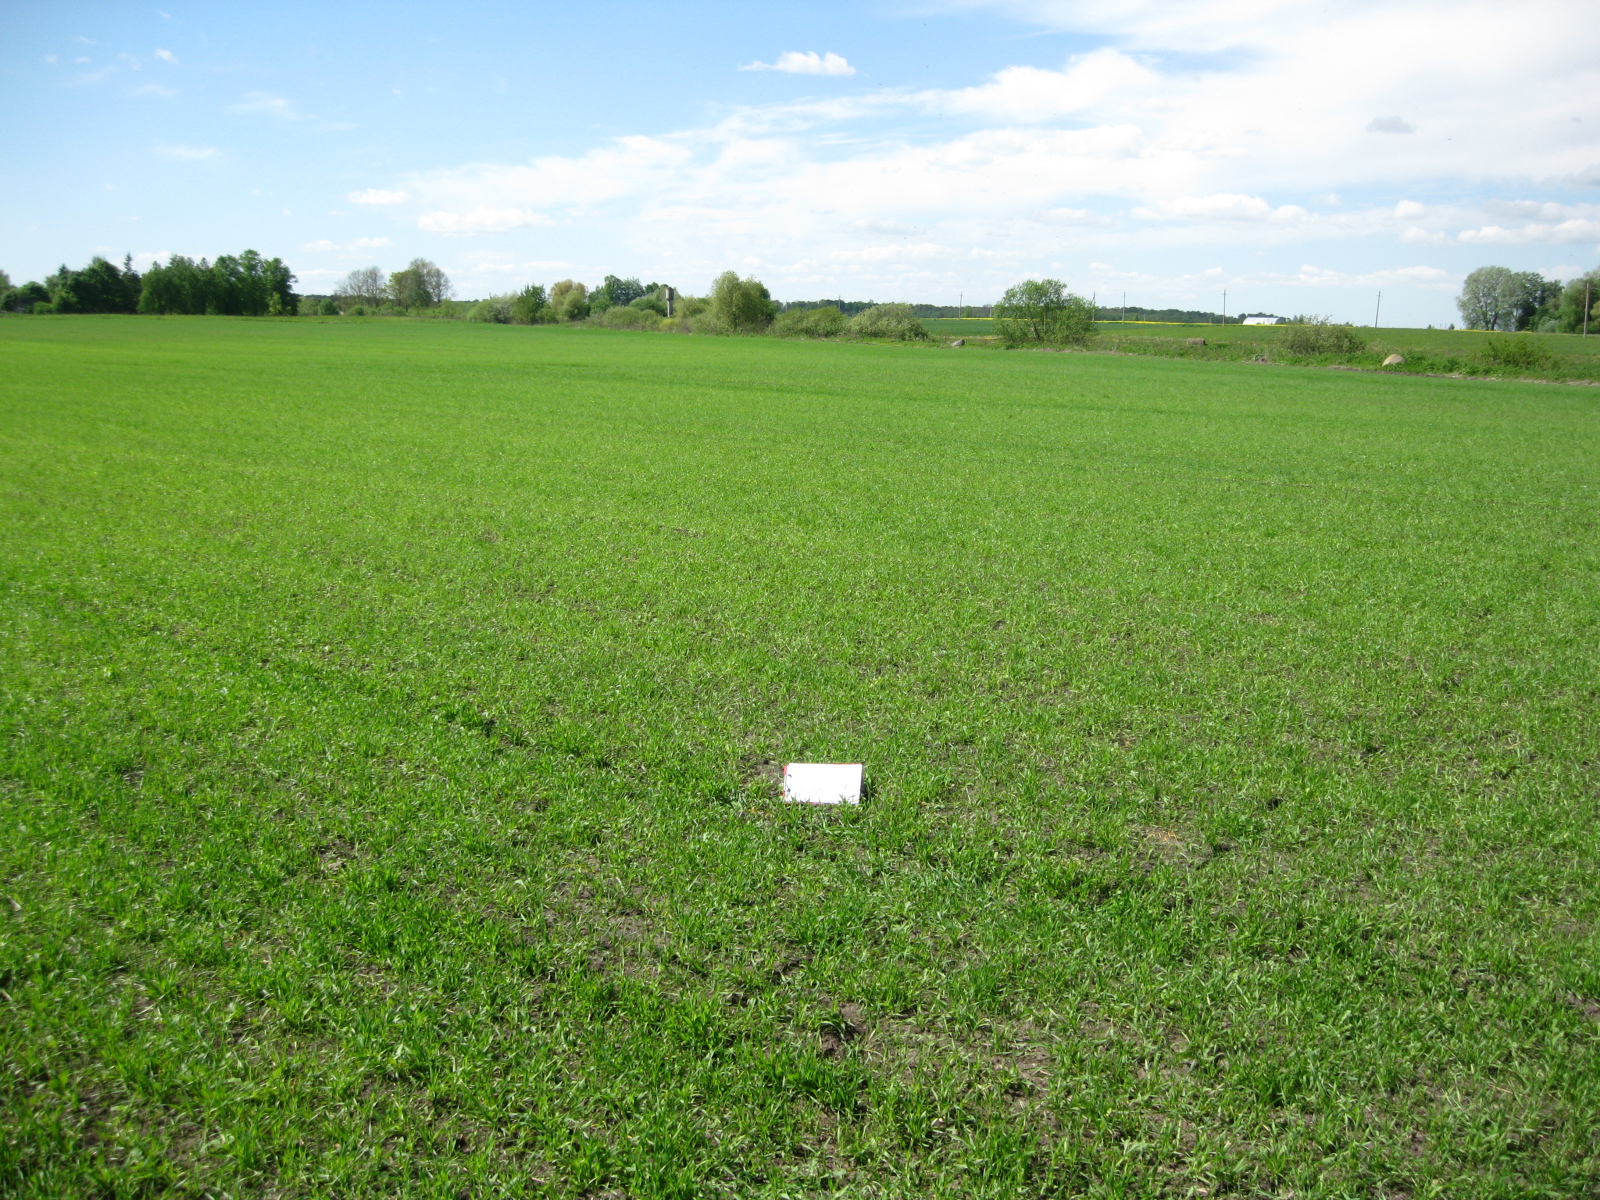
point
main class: Cropland
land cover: Barley
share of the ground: > 75 %
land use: Agriculture (excluding fallow land and kitchen gardens)
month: May
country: LT
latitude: 56.1488
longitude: 24.1421
